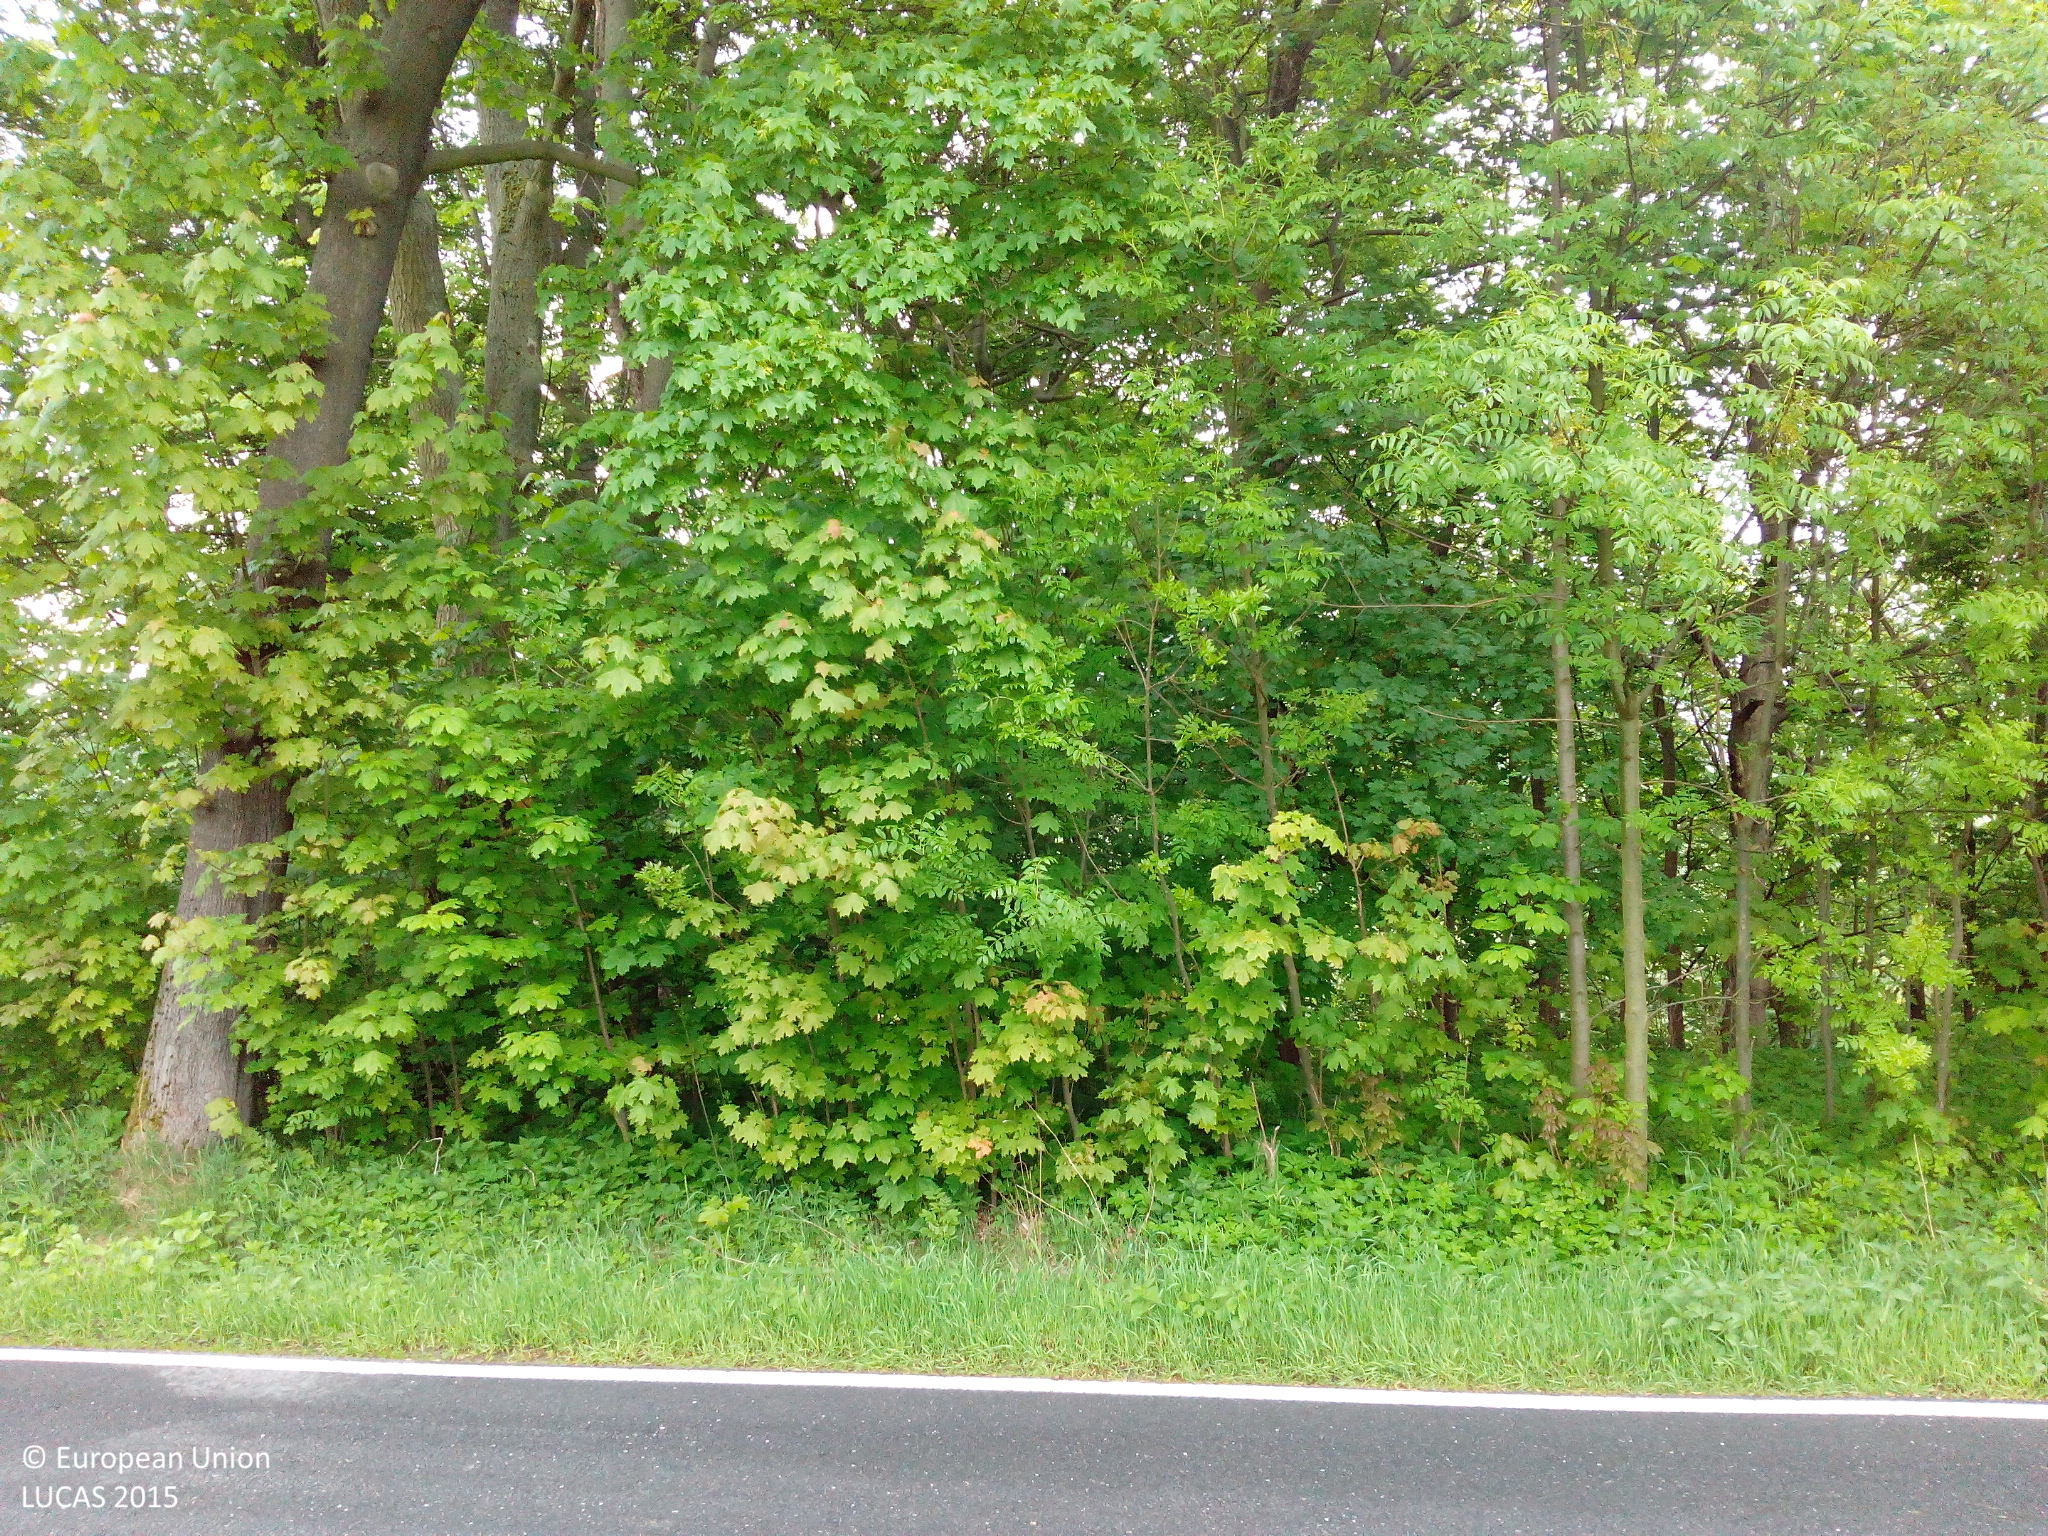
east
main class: Cropland
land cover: Barley
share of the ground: > 75 %
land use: Agriculture (excluding fallow land and kitchen gardens)
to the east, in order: Barley; Broadleaved woodland; Paved roads, cycling and walking lanes; Spruce dominated mixed woodland; Tracks; Spruce dominated mixed woodland; Fences; Grassland without tree/shrub cover
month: May
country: DE
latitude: 50.6109
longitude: 13.0666
